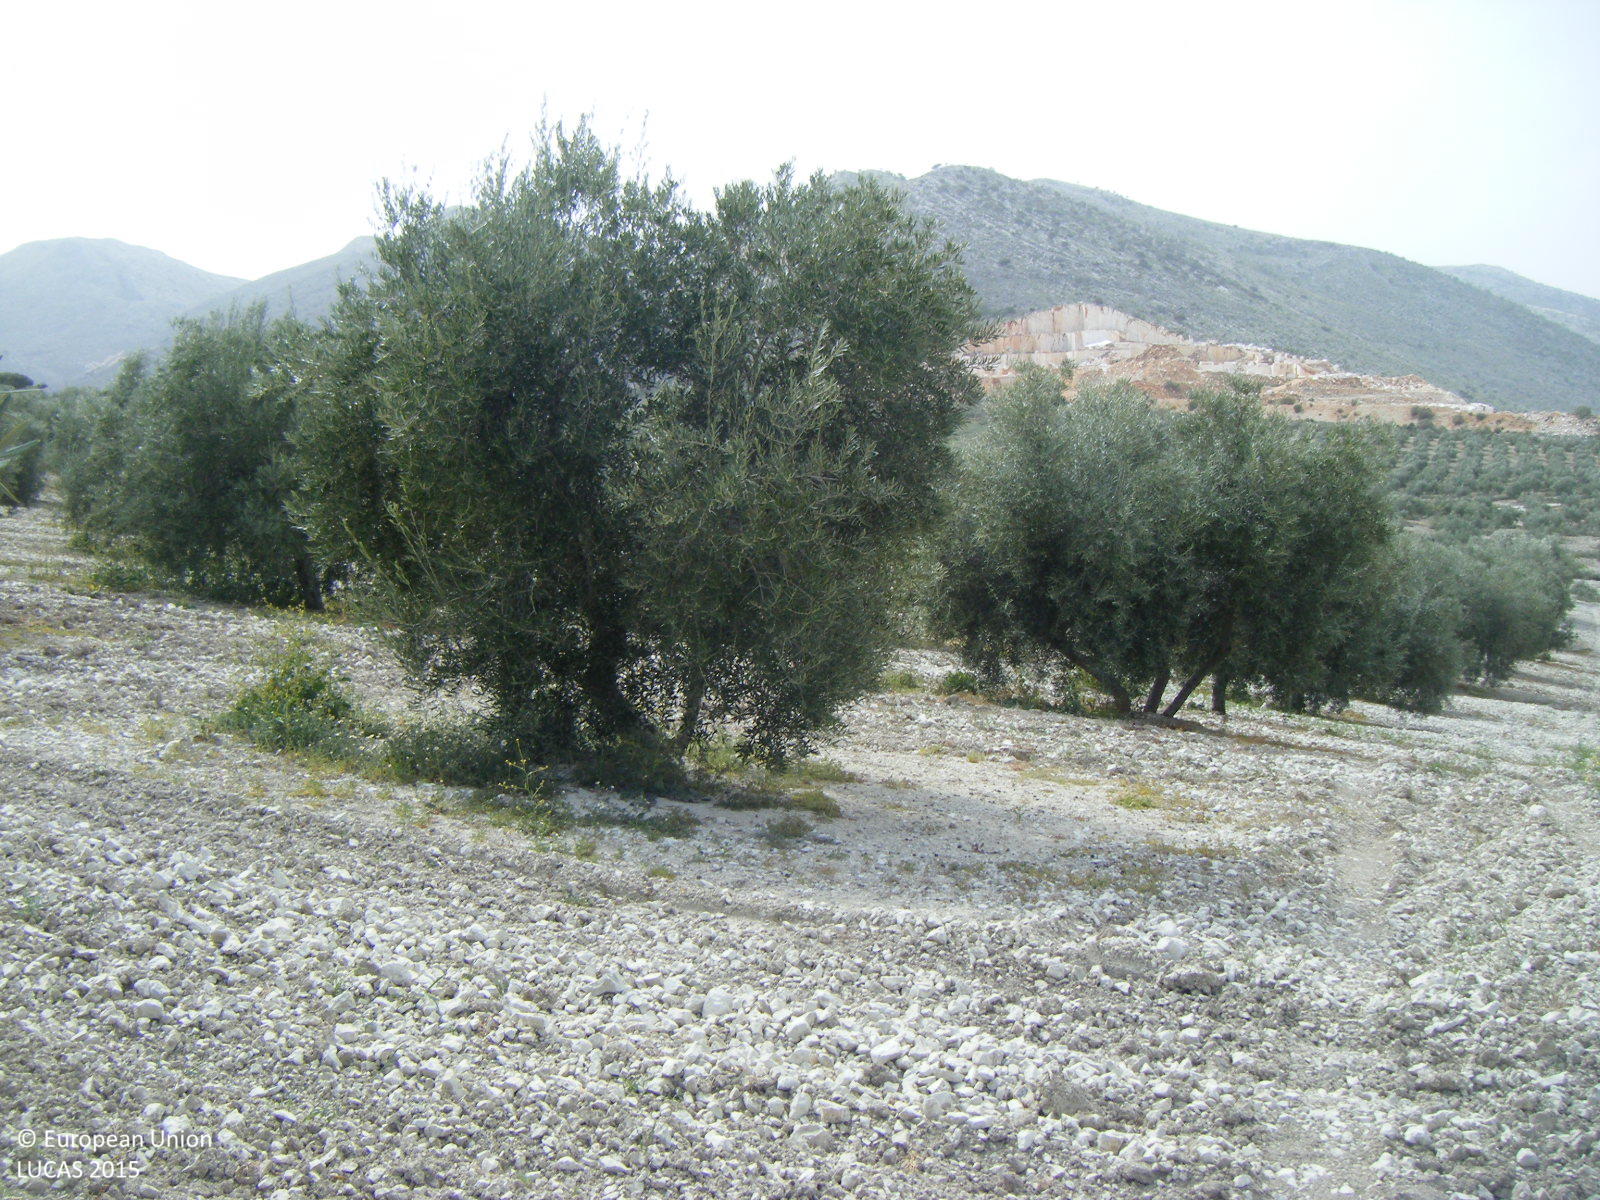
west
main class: Cropland
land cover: Olive groves
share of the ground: 10 - 25 %
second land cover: Other bare soil
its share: > 75 %
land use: Agriculture (excluding fallow land and kitchen gardens)
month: April
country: ES
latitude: 37.1003
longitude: -4.0687
